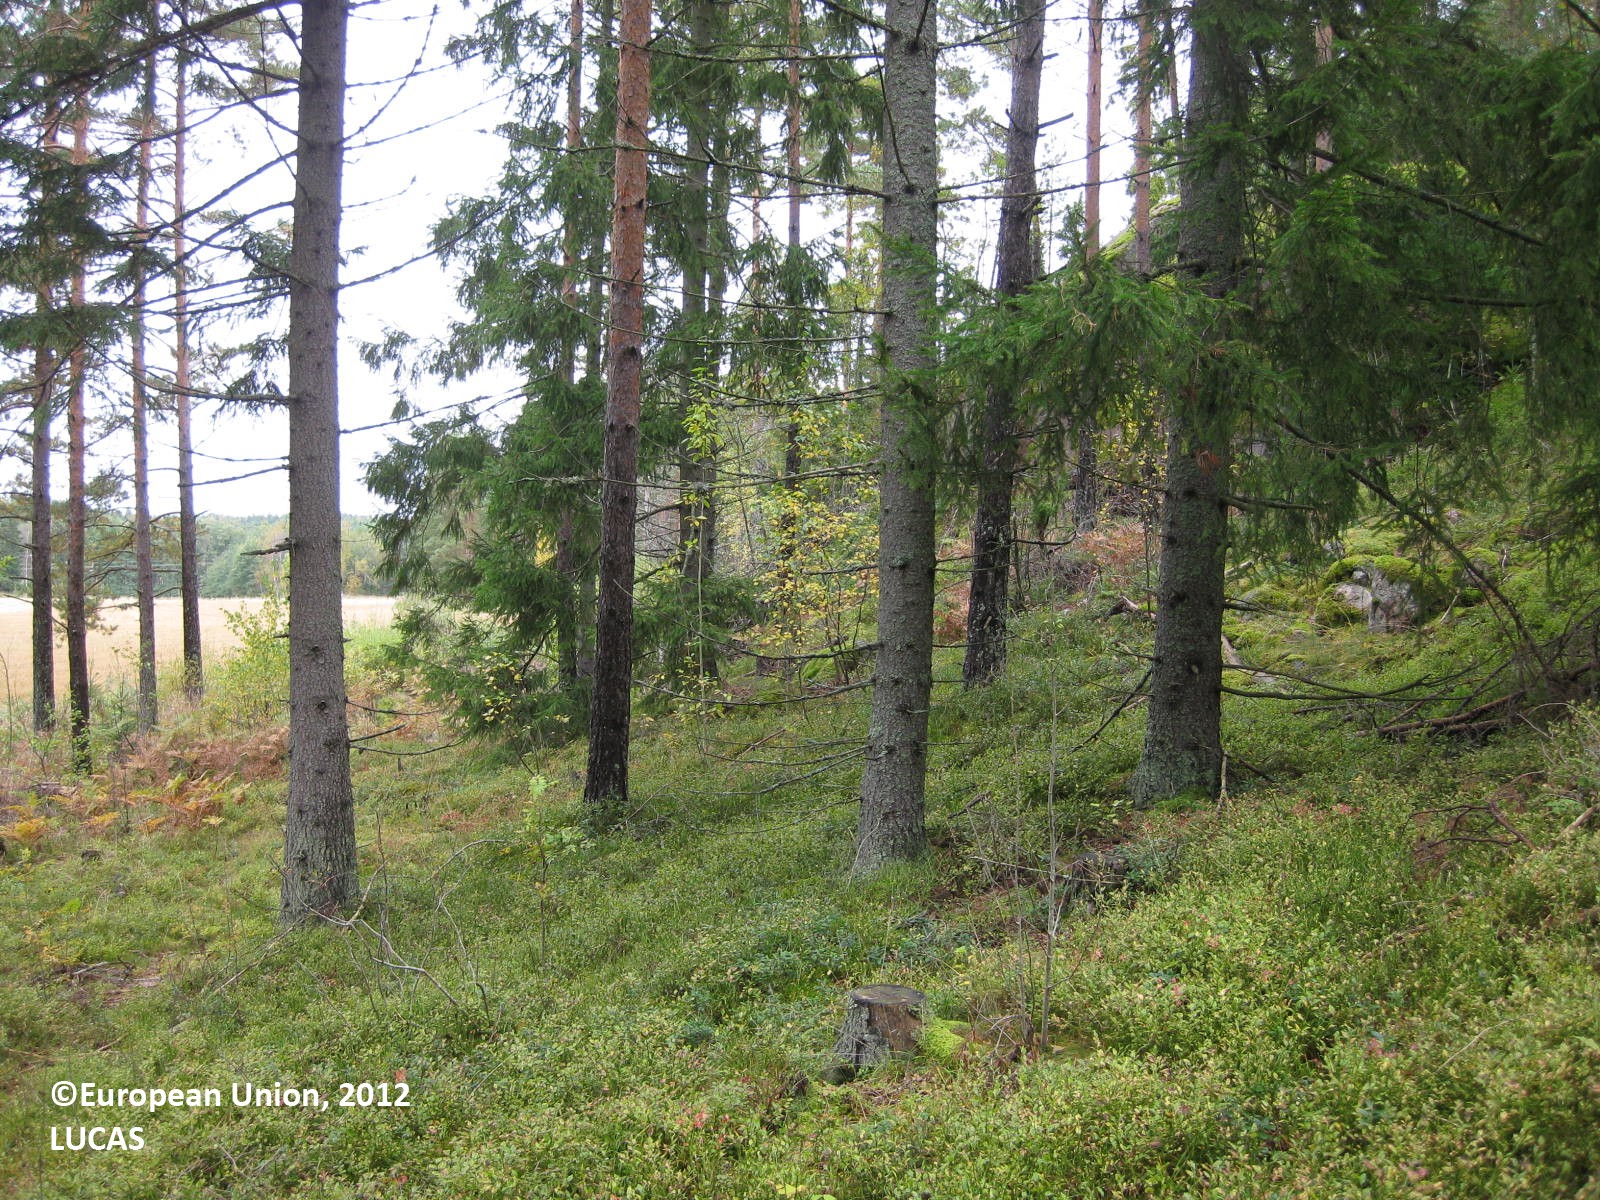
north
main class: Woodland
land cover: Other coniferous woodland
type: boreal forest
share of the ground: 25 - 50 %
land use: Forestry
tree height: > 5 m
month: September
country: FI
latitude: 60.3079
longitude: 22.1746
